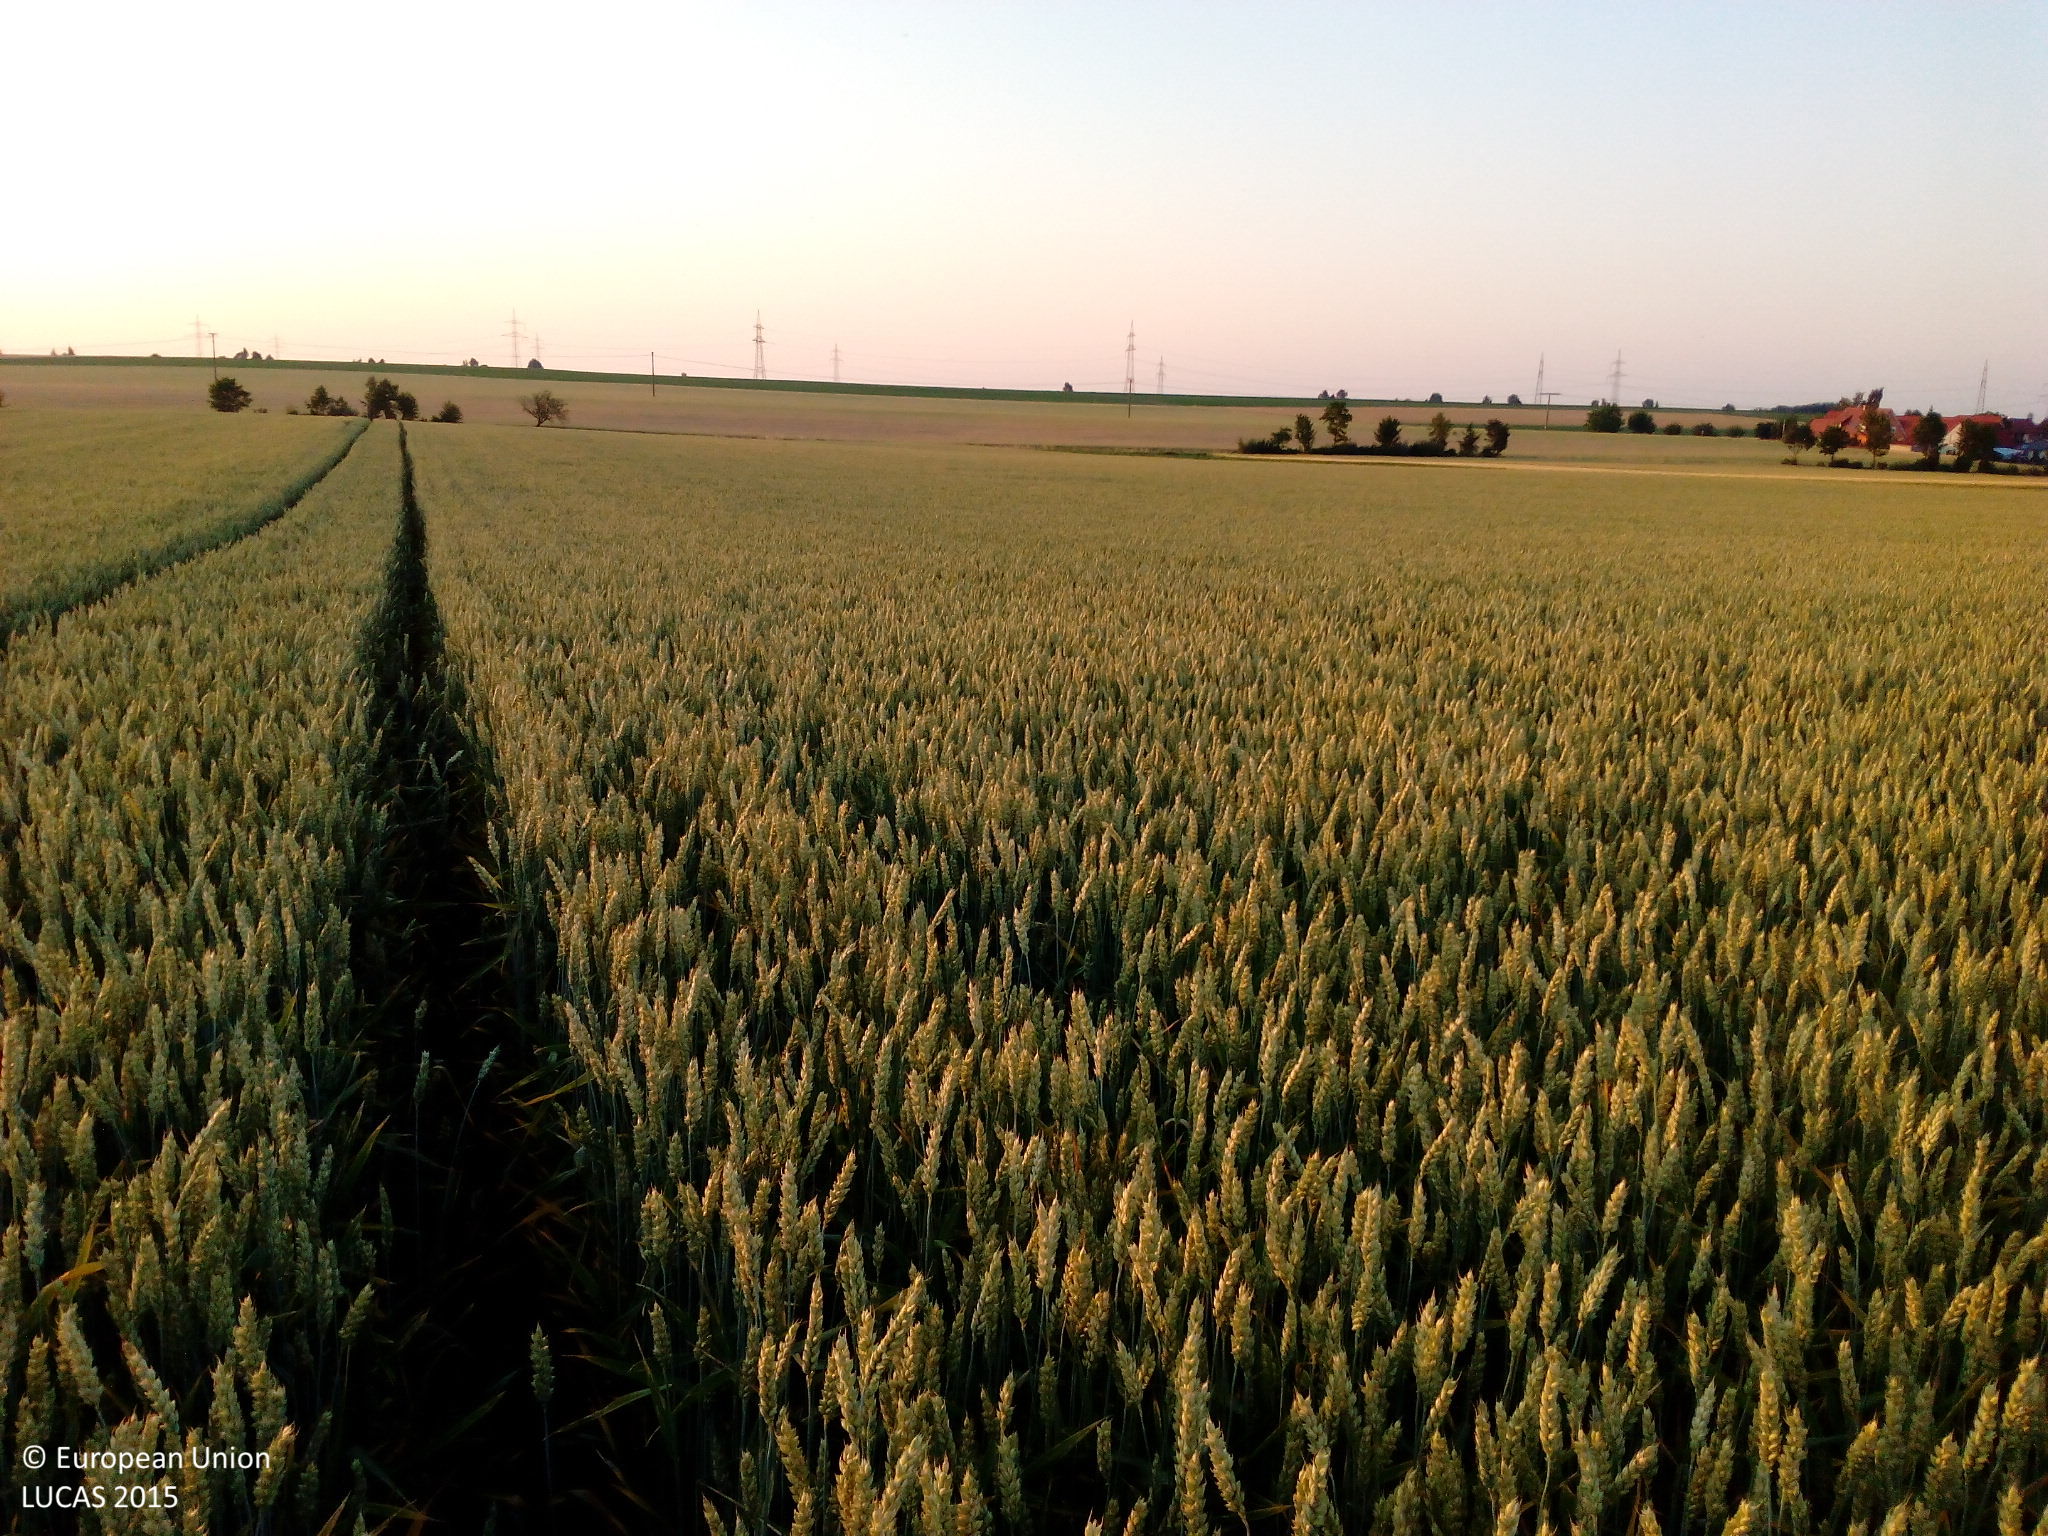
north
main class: Cropland
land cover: Common wheat
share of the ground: > 75 %
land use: Agriculture (excluding fallow land and kitchen gardens)
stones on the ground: < 10 %
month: July
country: DE
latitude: 49.5908
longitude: 9.9585
